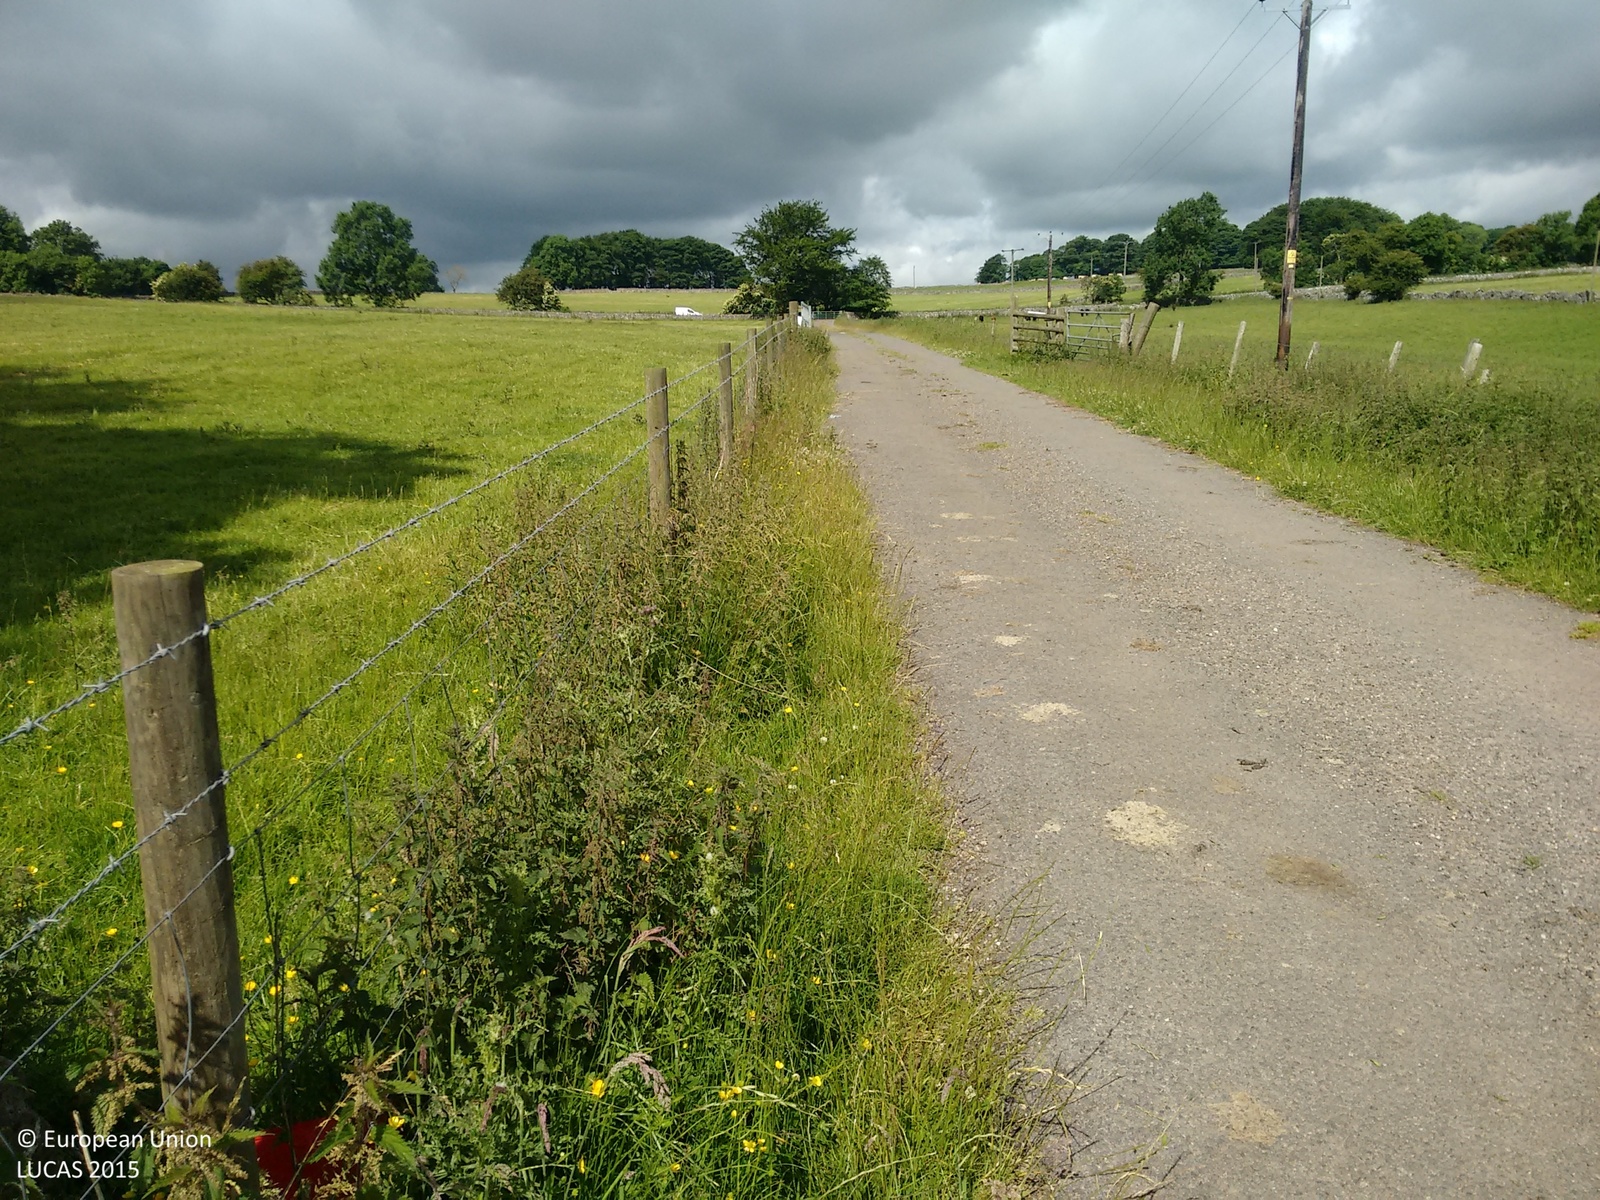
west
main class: Grassland
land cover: Grassland with sparse tree/shrub cover
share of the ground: > 75 %
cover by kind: herbaceous plants 85 %, shrubs 10 %, broadleaved forest trees 5 %
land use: Agriculture (excluding fallow land and kitchen gardens)
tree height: > 5 m
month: July
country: GB
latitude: 53.1564
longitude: -1.7334
